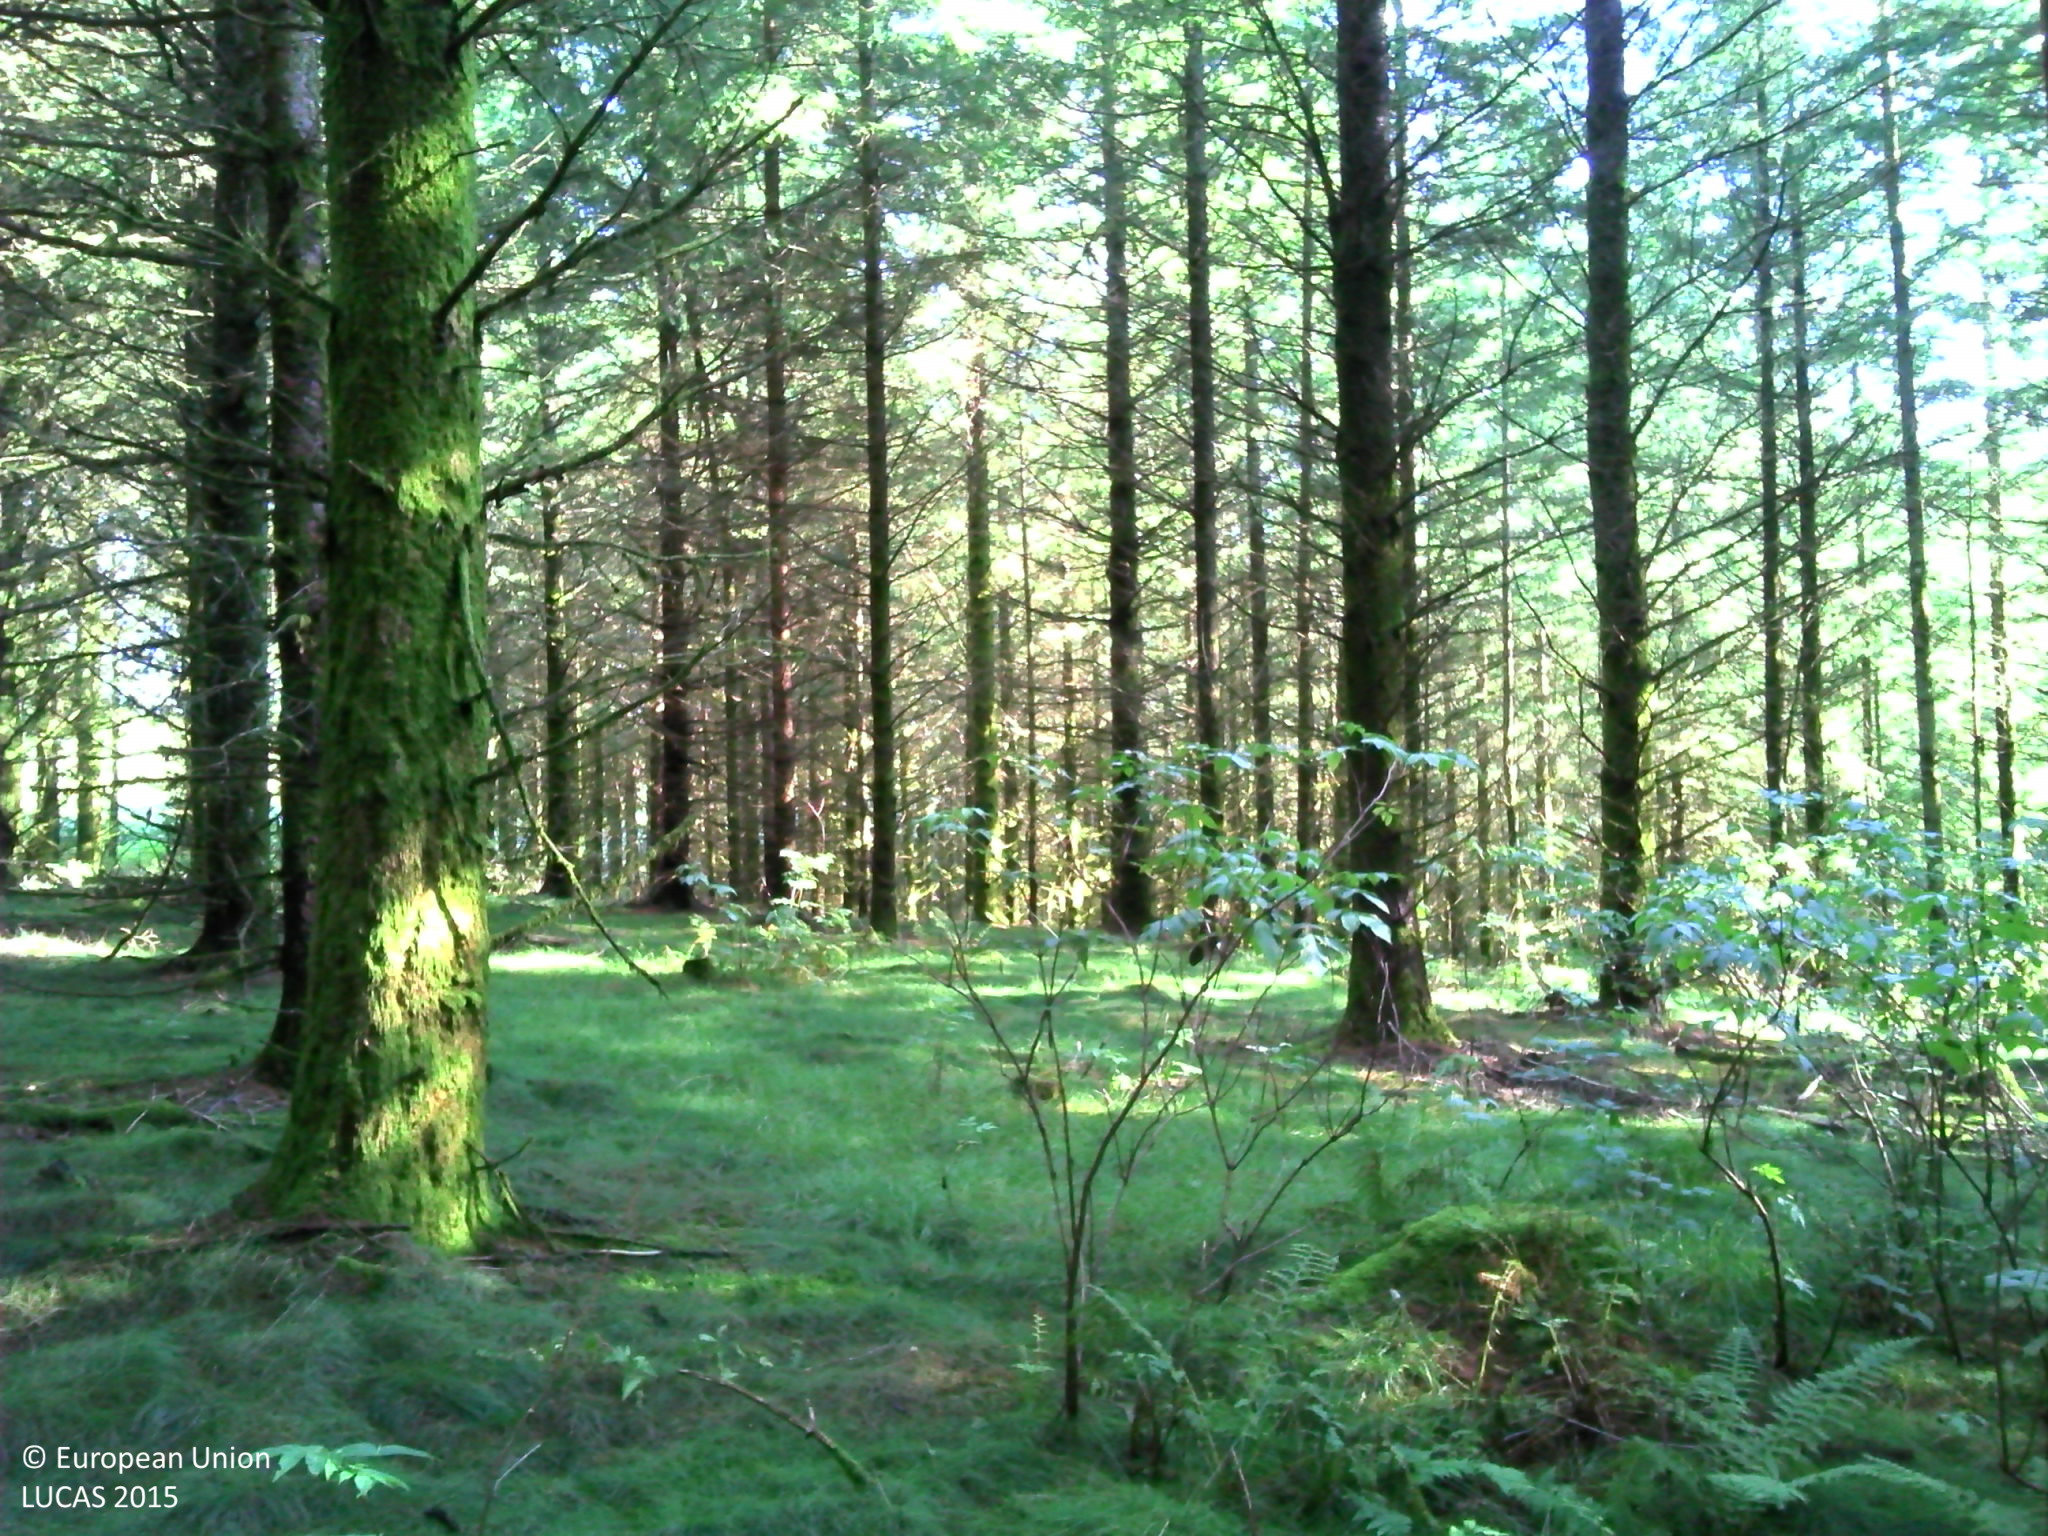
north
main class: Woodland
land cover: Spruce dominated coniferous woodland
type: exotic forest
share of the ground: > 75 %
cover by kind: coniferous forest trees 70 %, herbaceous plants 30 %
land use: Forestry
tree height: > 5 m
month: August
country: FR
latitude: 45.5341
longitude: 1.8640
